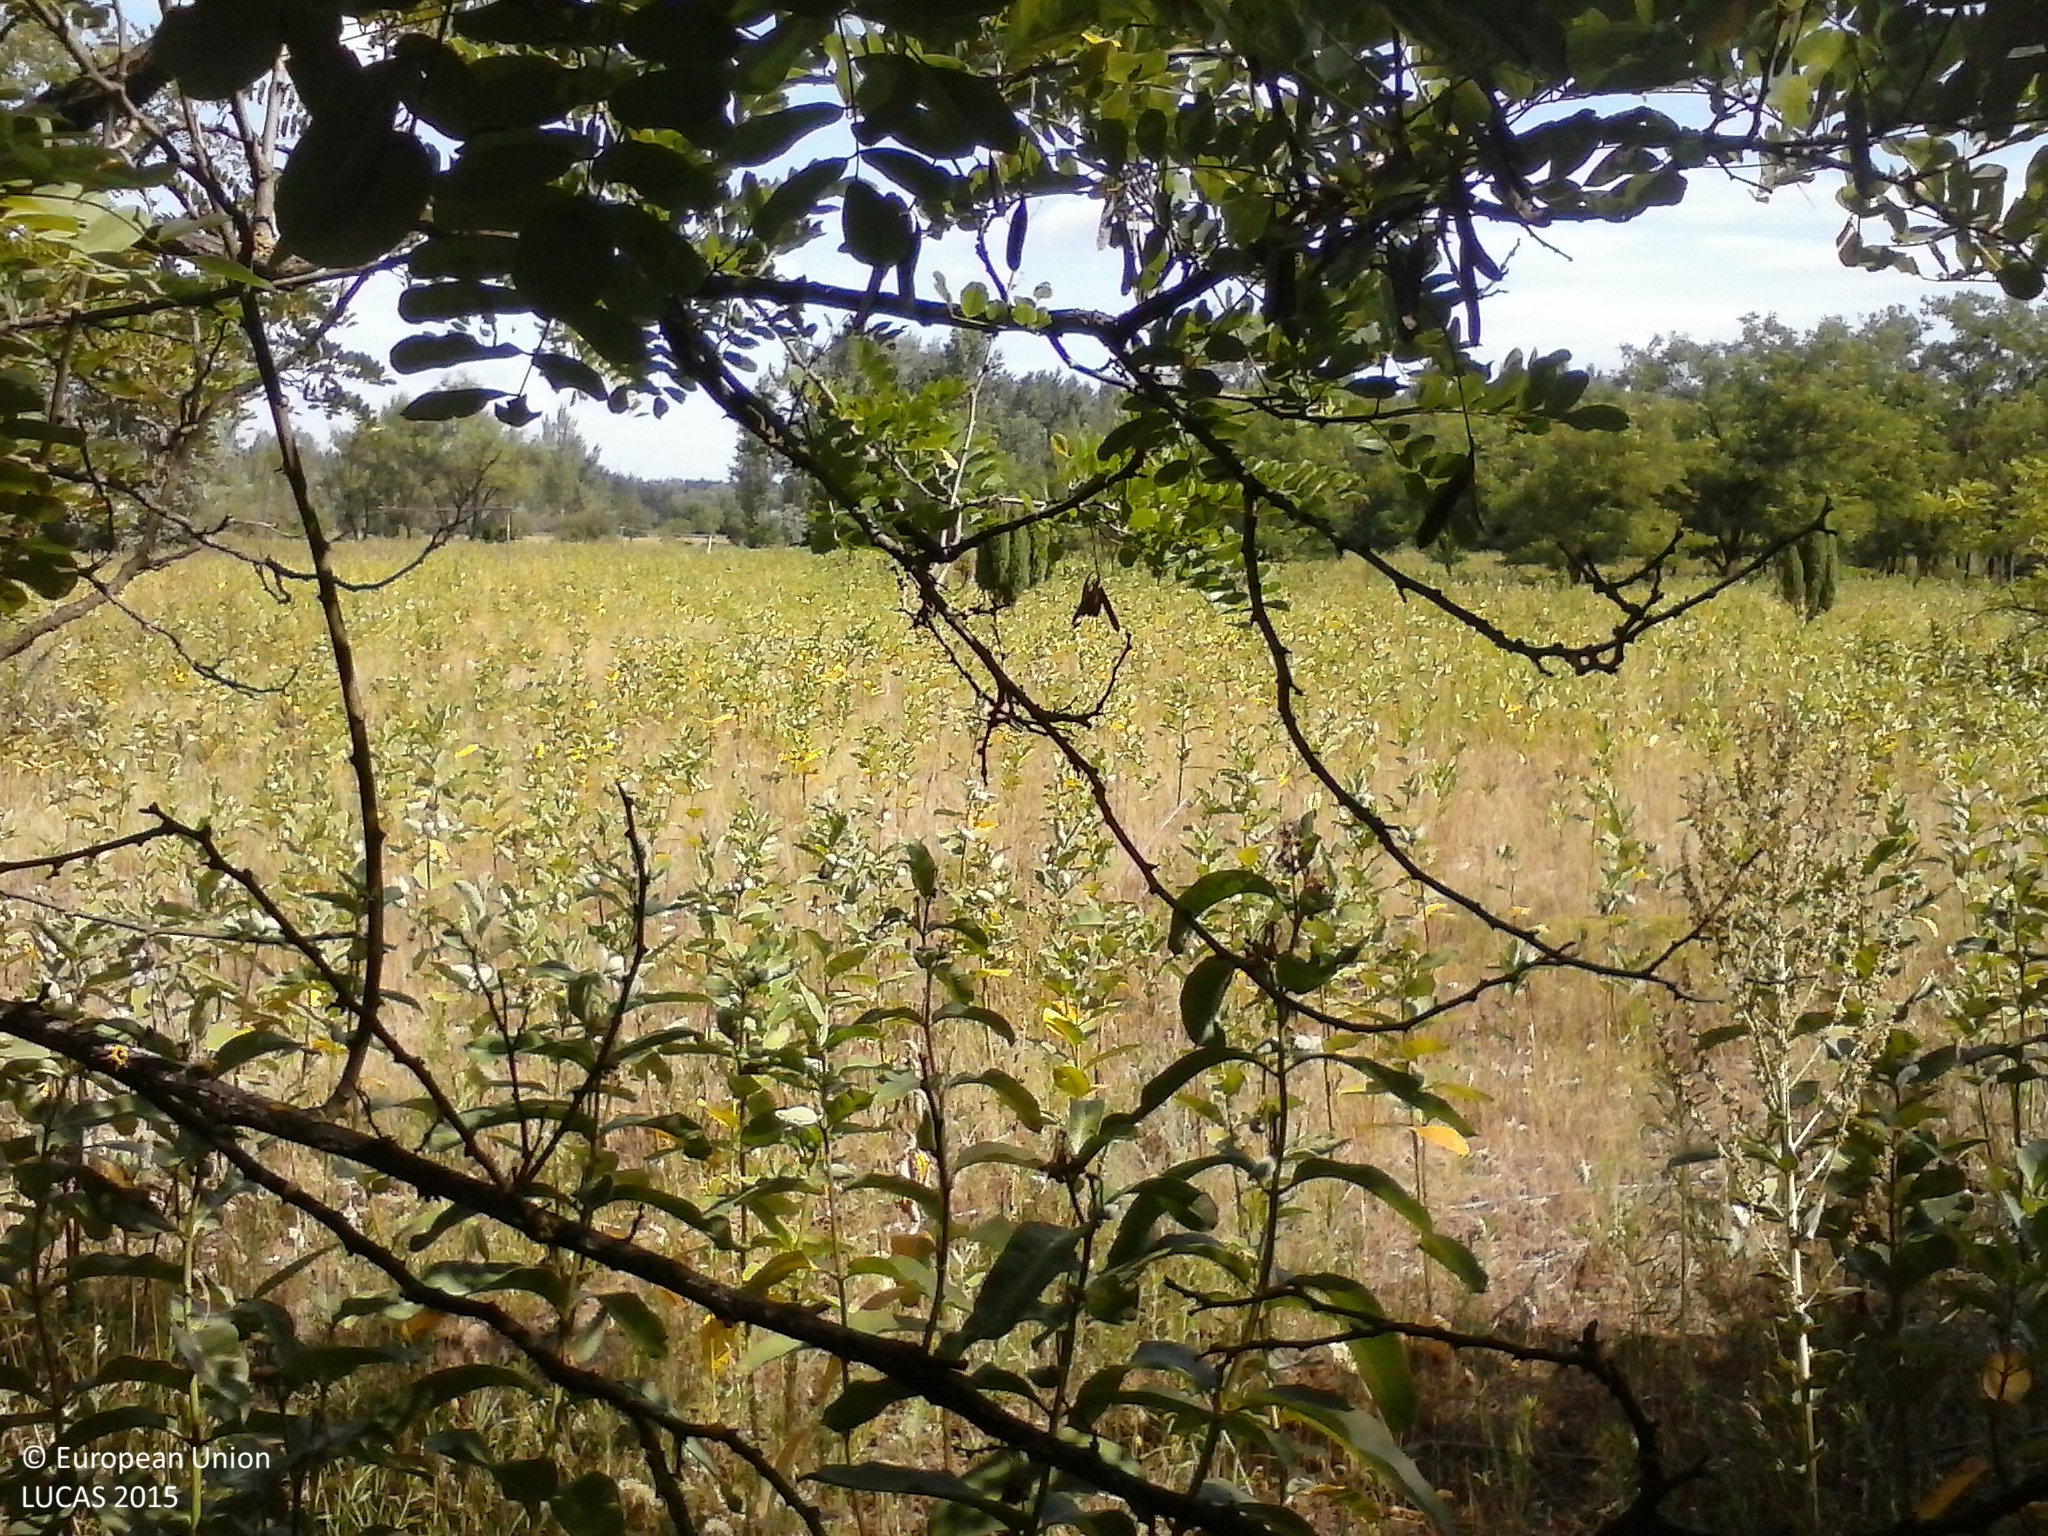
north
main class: Woodland
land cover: Broadleaved woodland
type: mesophytic deciduous forest
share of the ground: 50 - 75 %
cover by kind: broadleaved forest trees 70 %, shrubs 15 %, herbaceous plants 15 %
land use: Semi-natural and natural areas not in use
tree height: > 5 m
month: July
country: HU
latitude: 46.5705
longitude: 19.6082
